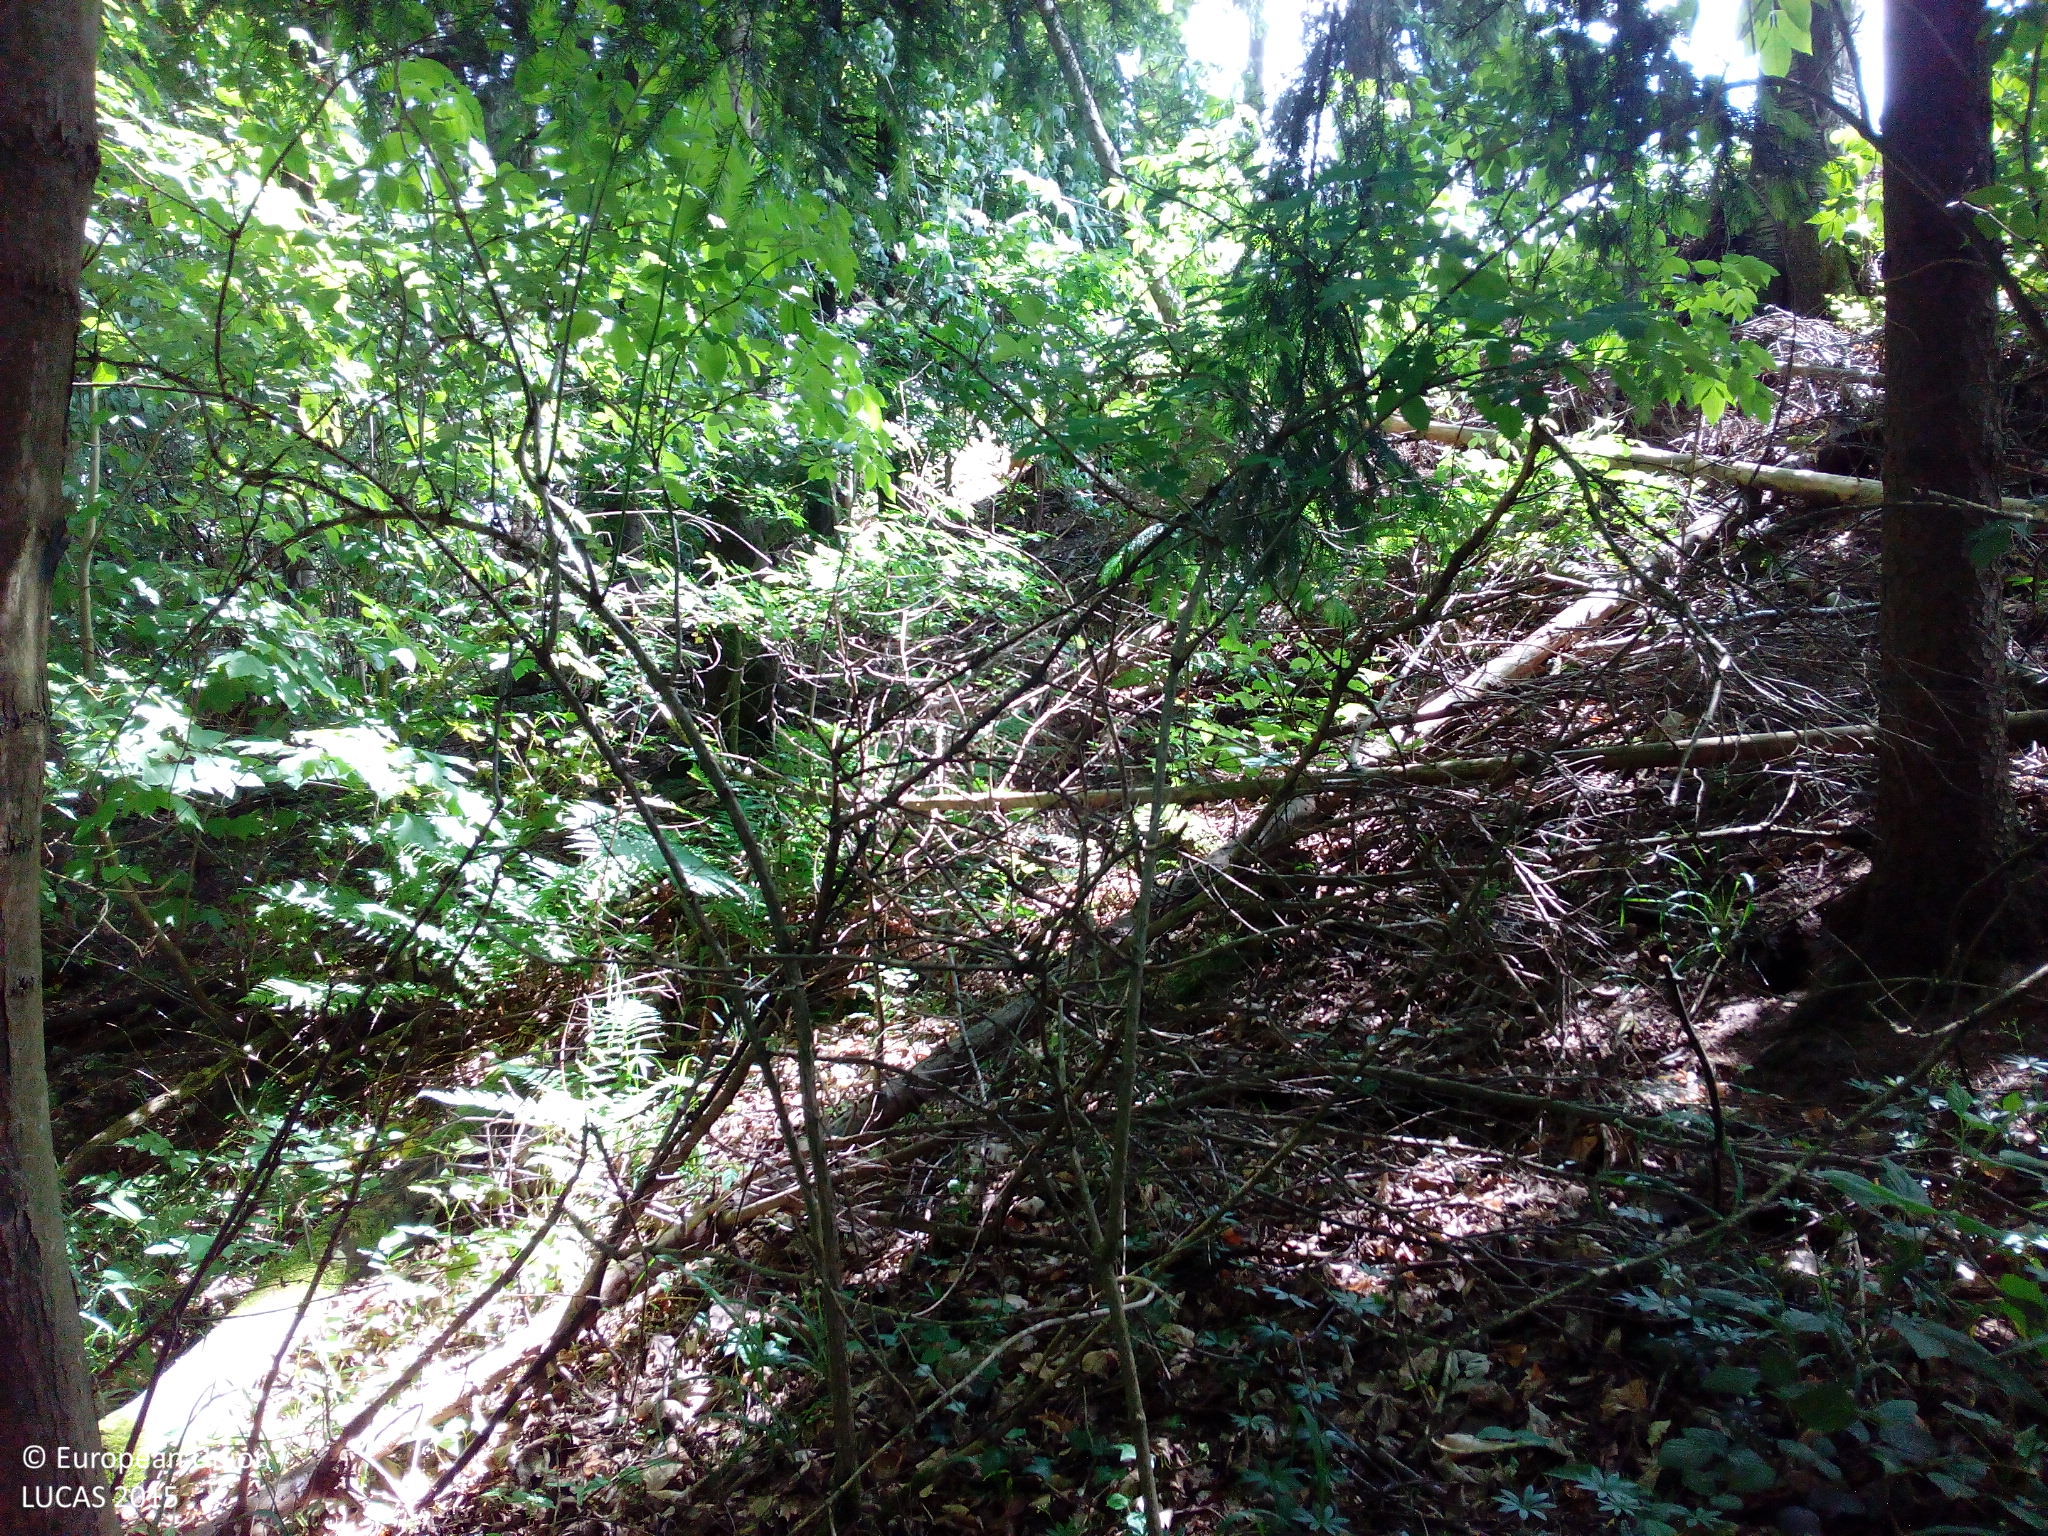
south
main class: Woodland
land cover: Broadleaved woodland
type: mesophytic deciduous forest
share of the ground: > 75 %
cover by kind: broadleaved forest trees 85 %, shrubs 10 %, coniferous forest trees 5 %
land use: Forestry
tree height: > 5 m
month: June
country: DE
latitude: 49.0495
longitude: 9.3846
